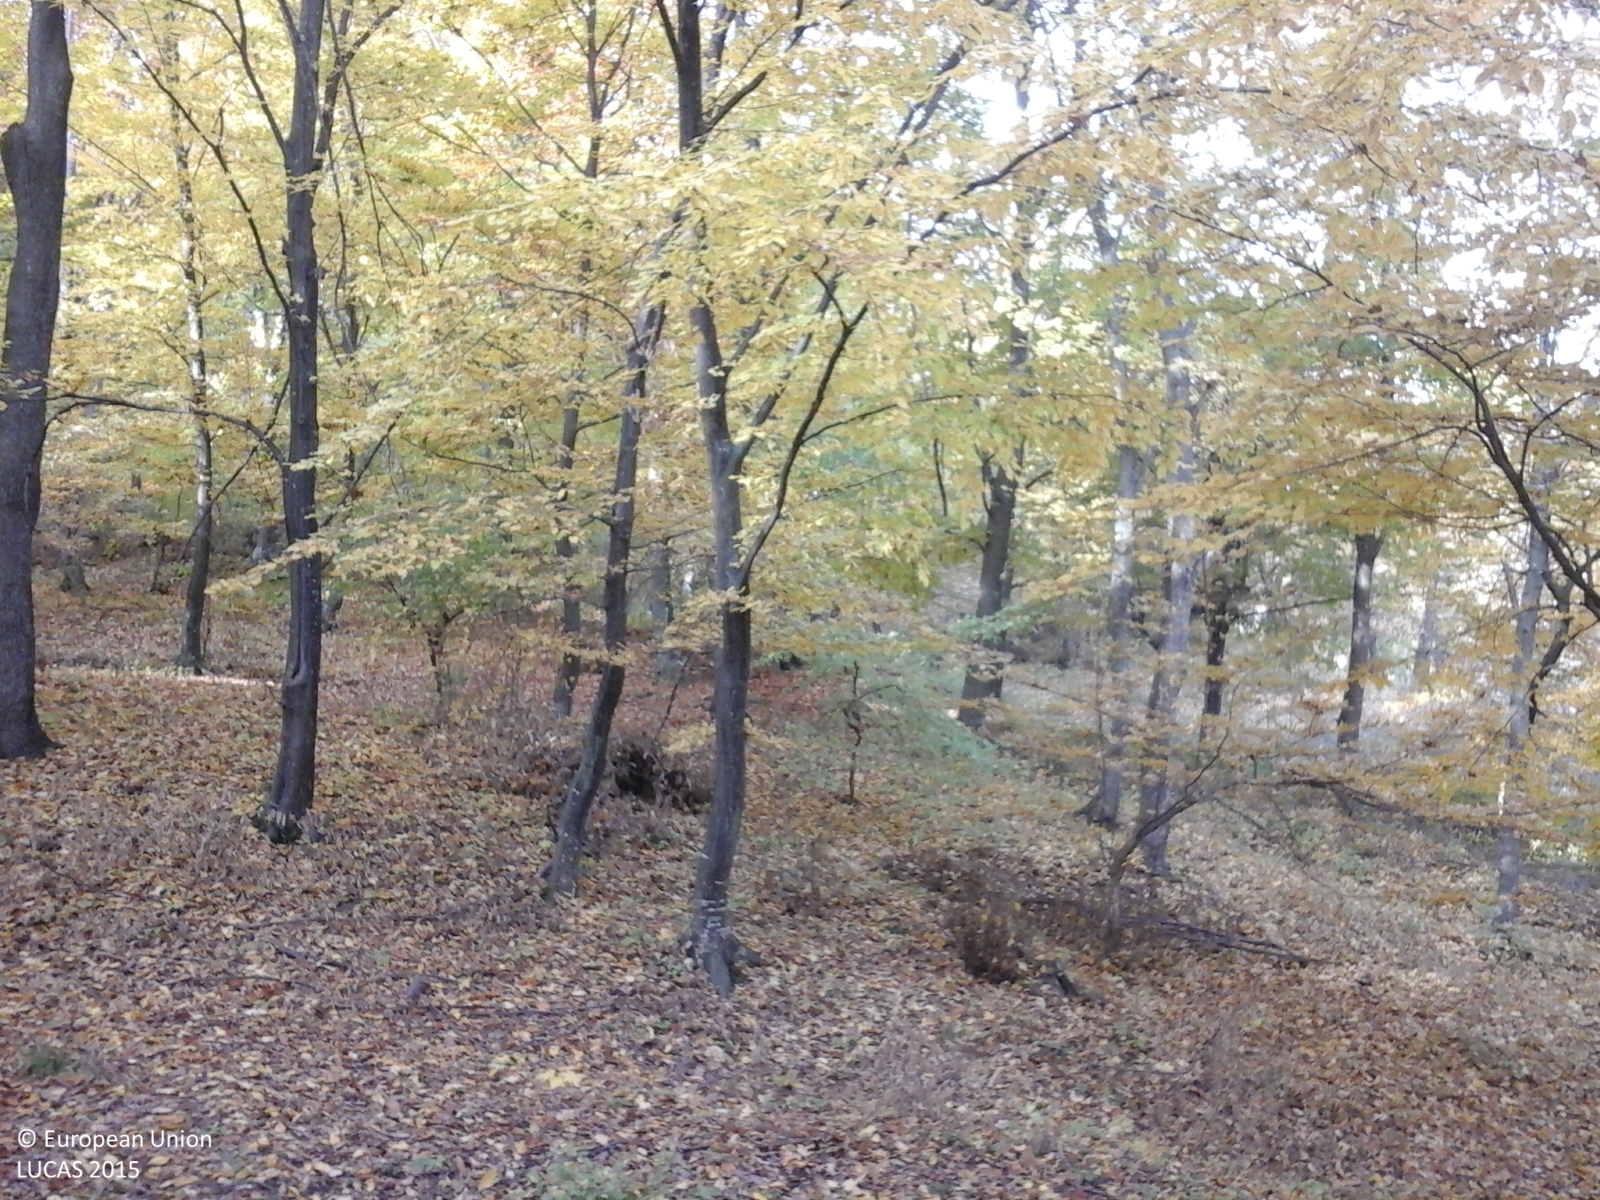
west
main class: Woodland
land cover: Broadleaved woodland
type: beech forest
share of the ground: > 75 %
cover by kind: broadleaved forest trees 100 %
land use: Forestry
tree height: > 5 m
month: October
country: RO
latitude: 45.6378
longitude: 27.0108
